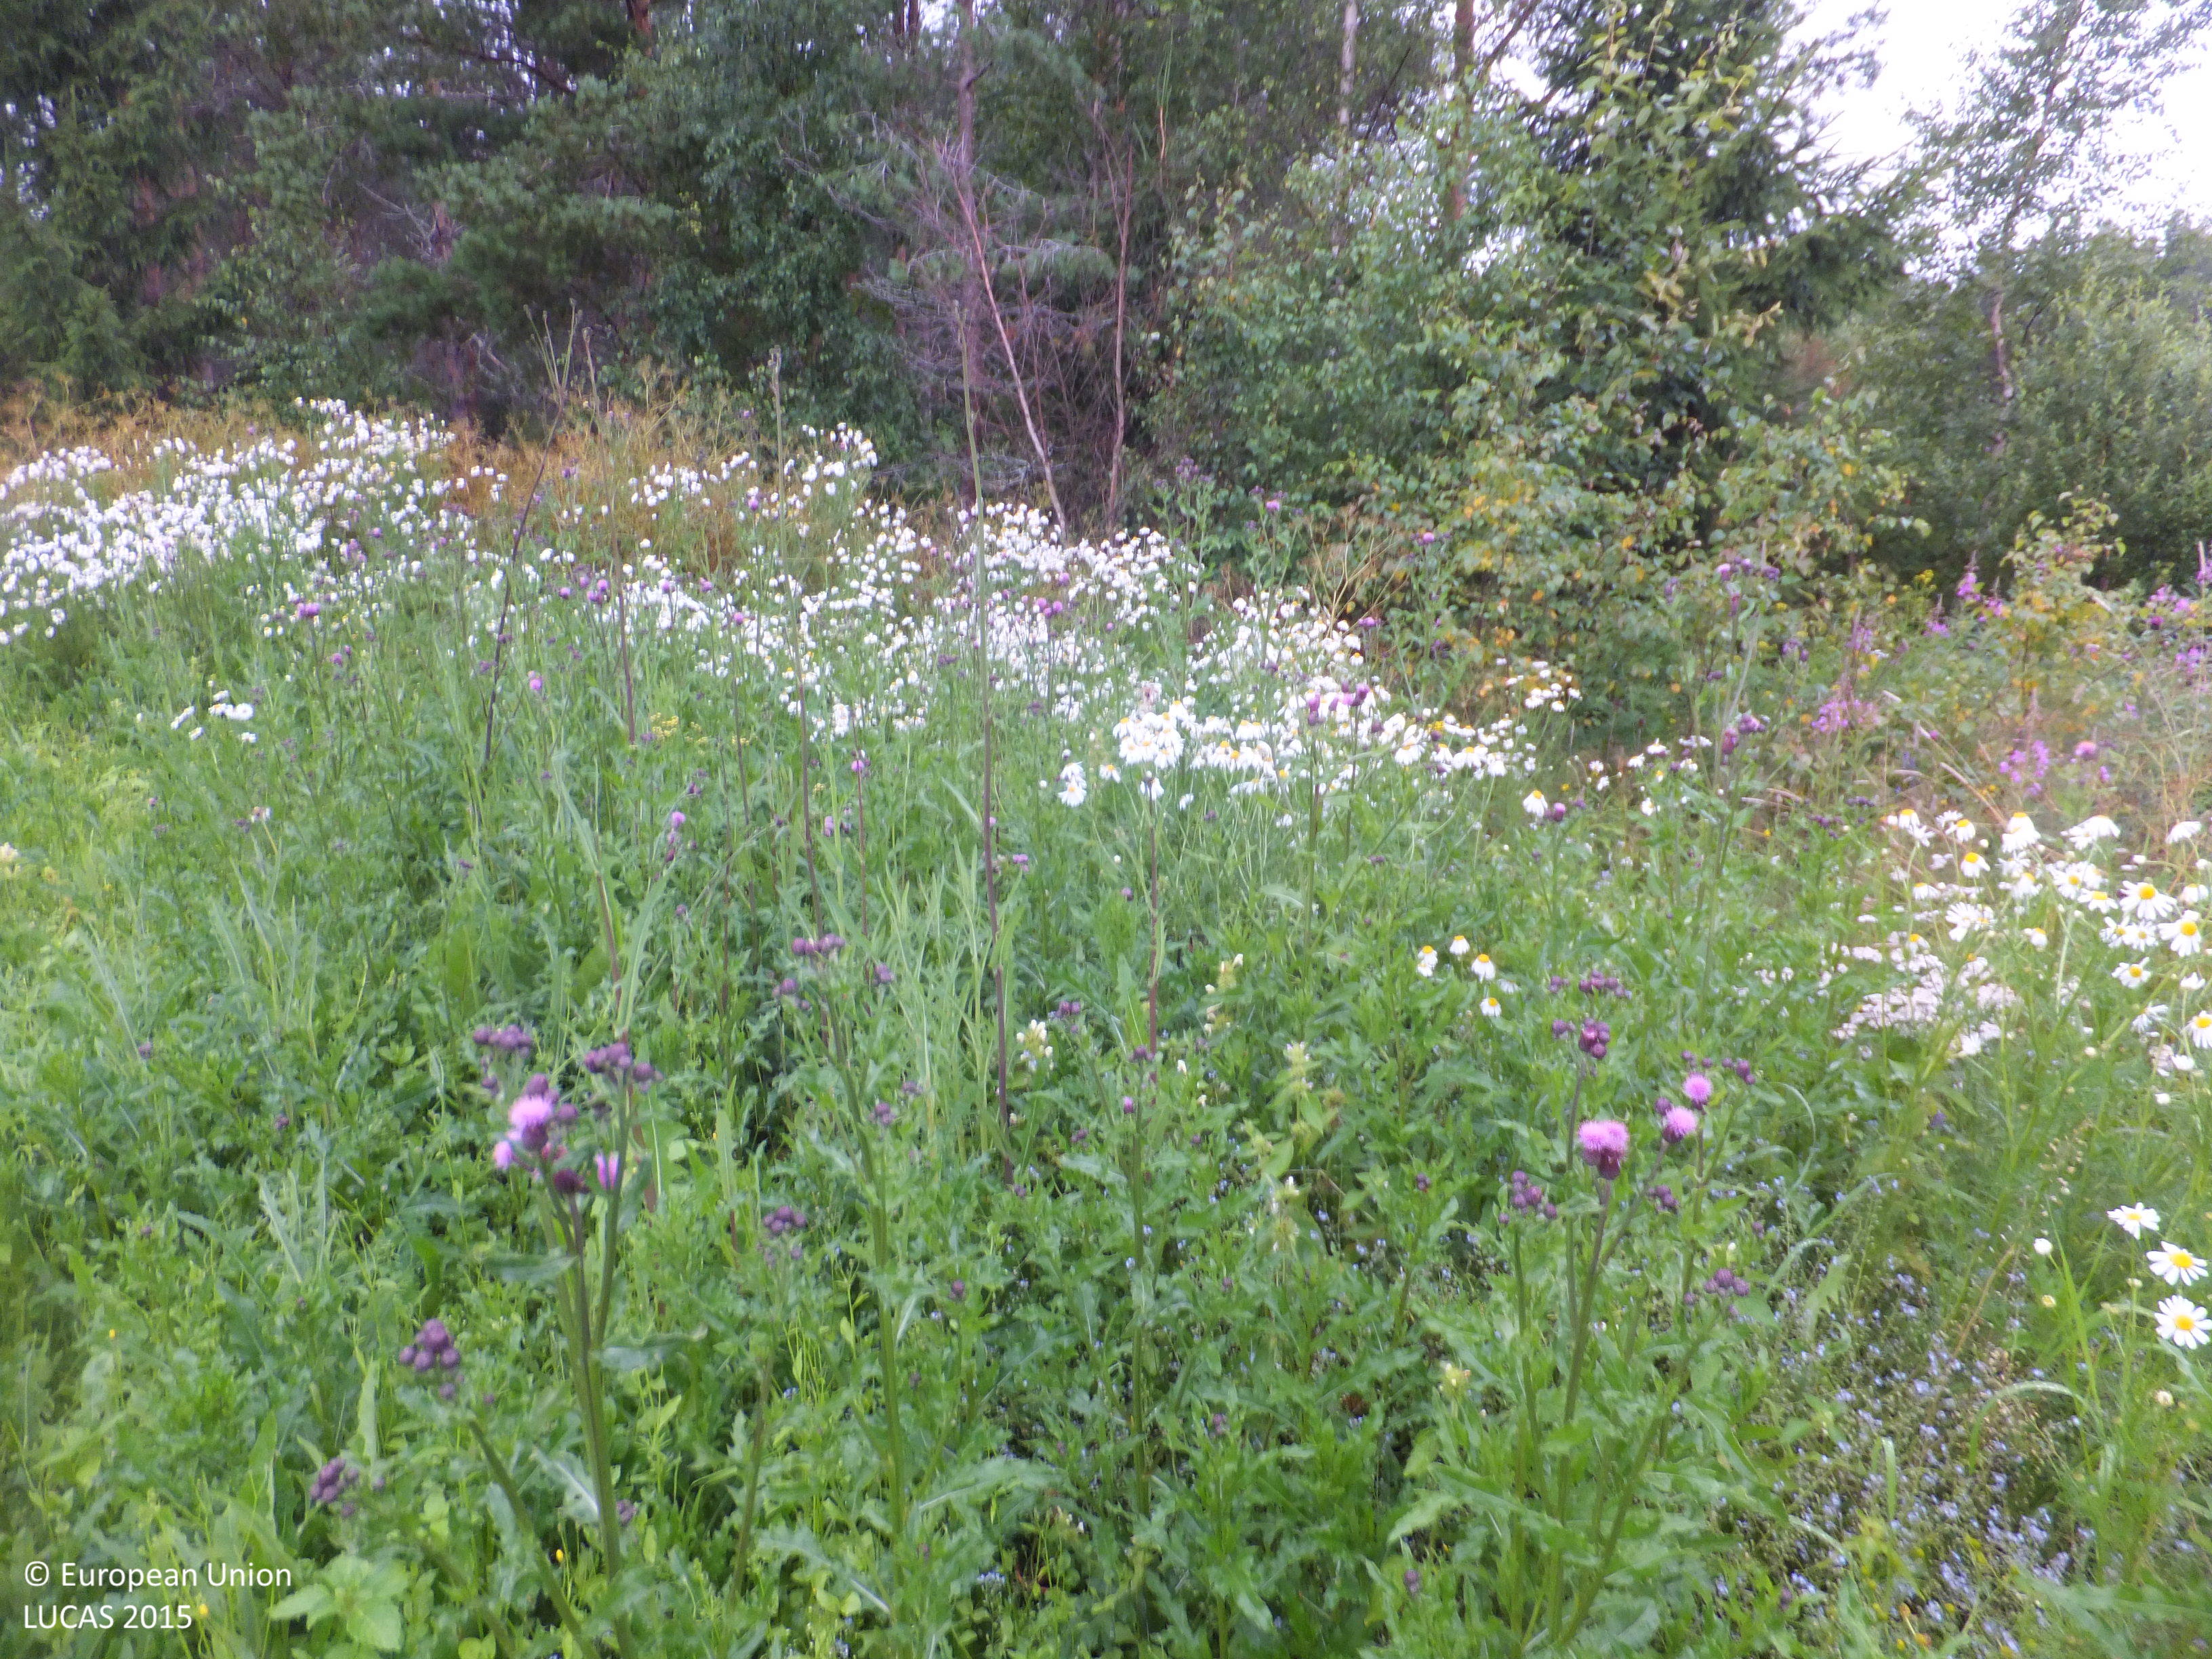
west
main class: Grassland
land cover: Grassland without tree/shrub cover
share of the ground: > 75 %
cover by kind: herbaceous plants 95 %, shrubs 5 %
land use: Agriculture (excluding fallow land and kitchen gardens)
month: July
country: FI
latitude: 63.0764
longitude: 22.0611
